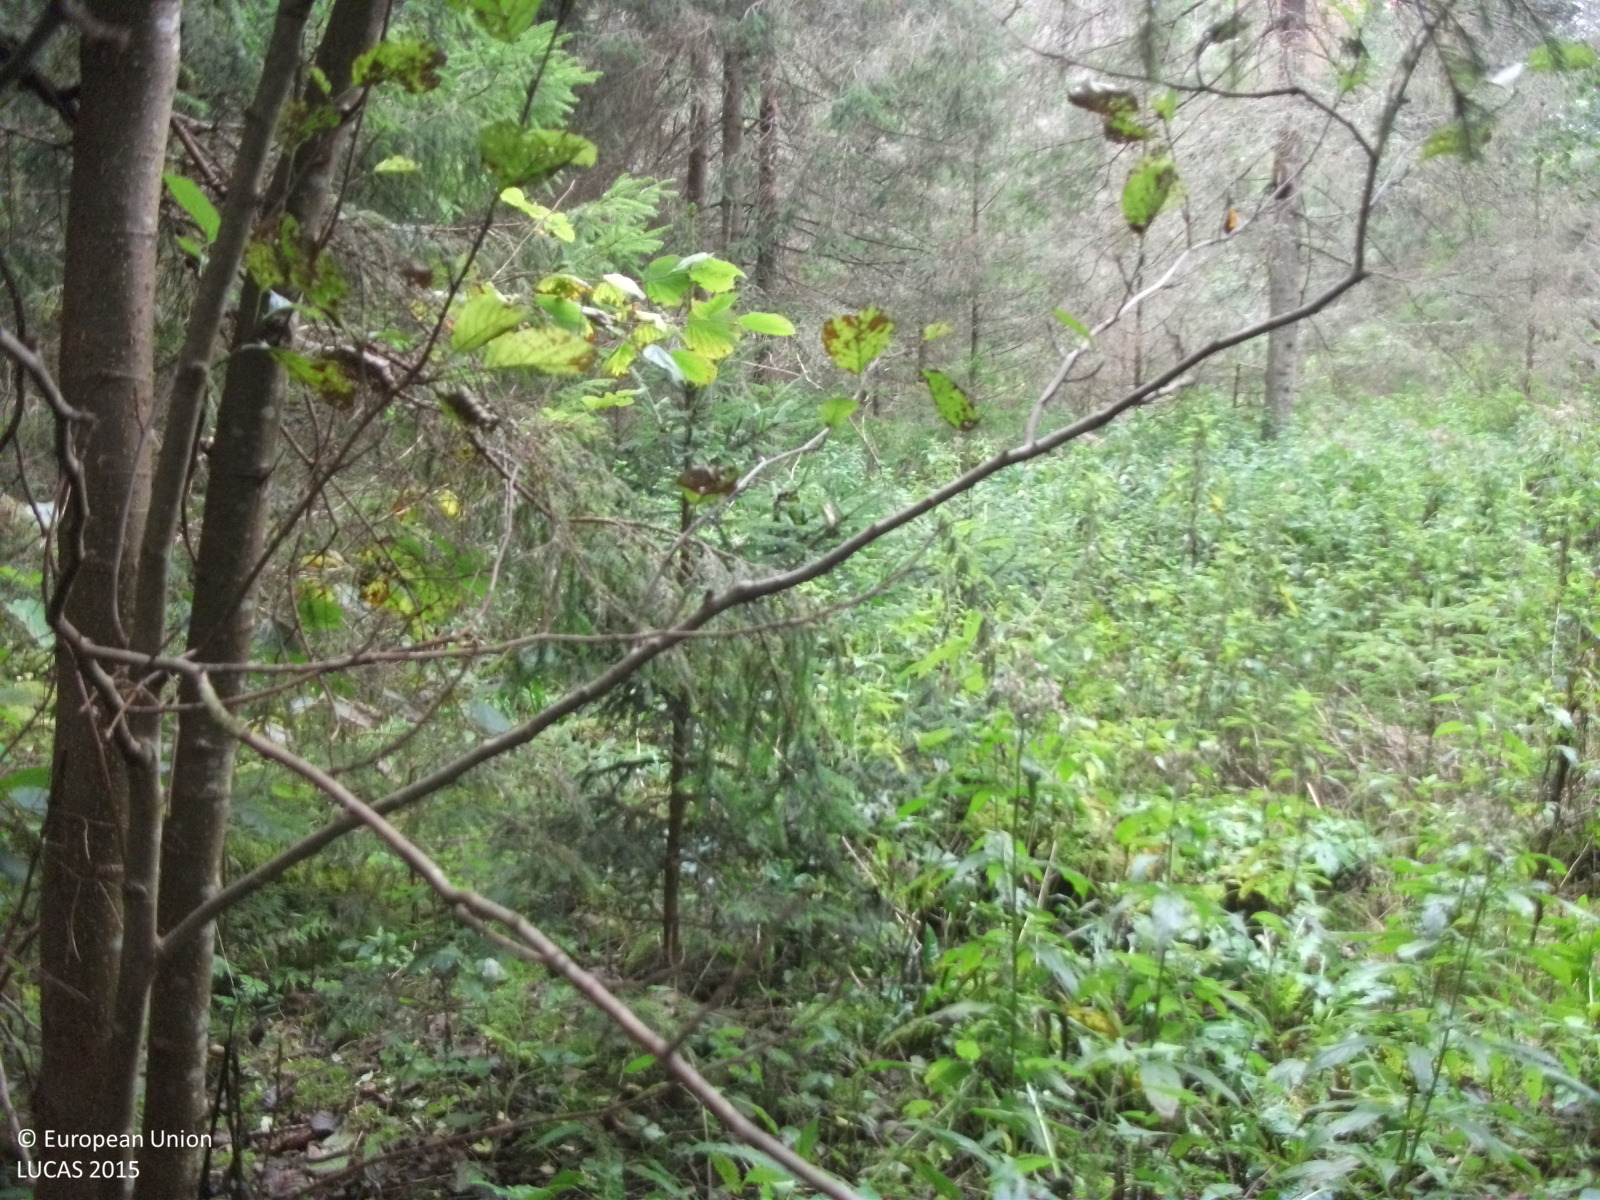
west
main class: Woodland
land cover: Spruce dominated mixed woodland
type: hemiboreal forest and nemoral coniferous forest and mixed broadleaved-coniferous forest
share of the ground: > 75 %
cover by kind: coniferous forest trees 60 %, broadleaved forest trees 25 %, herbaceous plants 10 %, shrubs 5 %
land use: Forestry
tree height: > 5 m
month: September
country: LV
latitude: 57.7439
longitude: 24.4521
